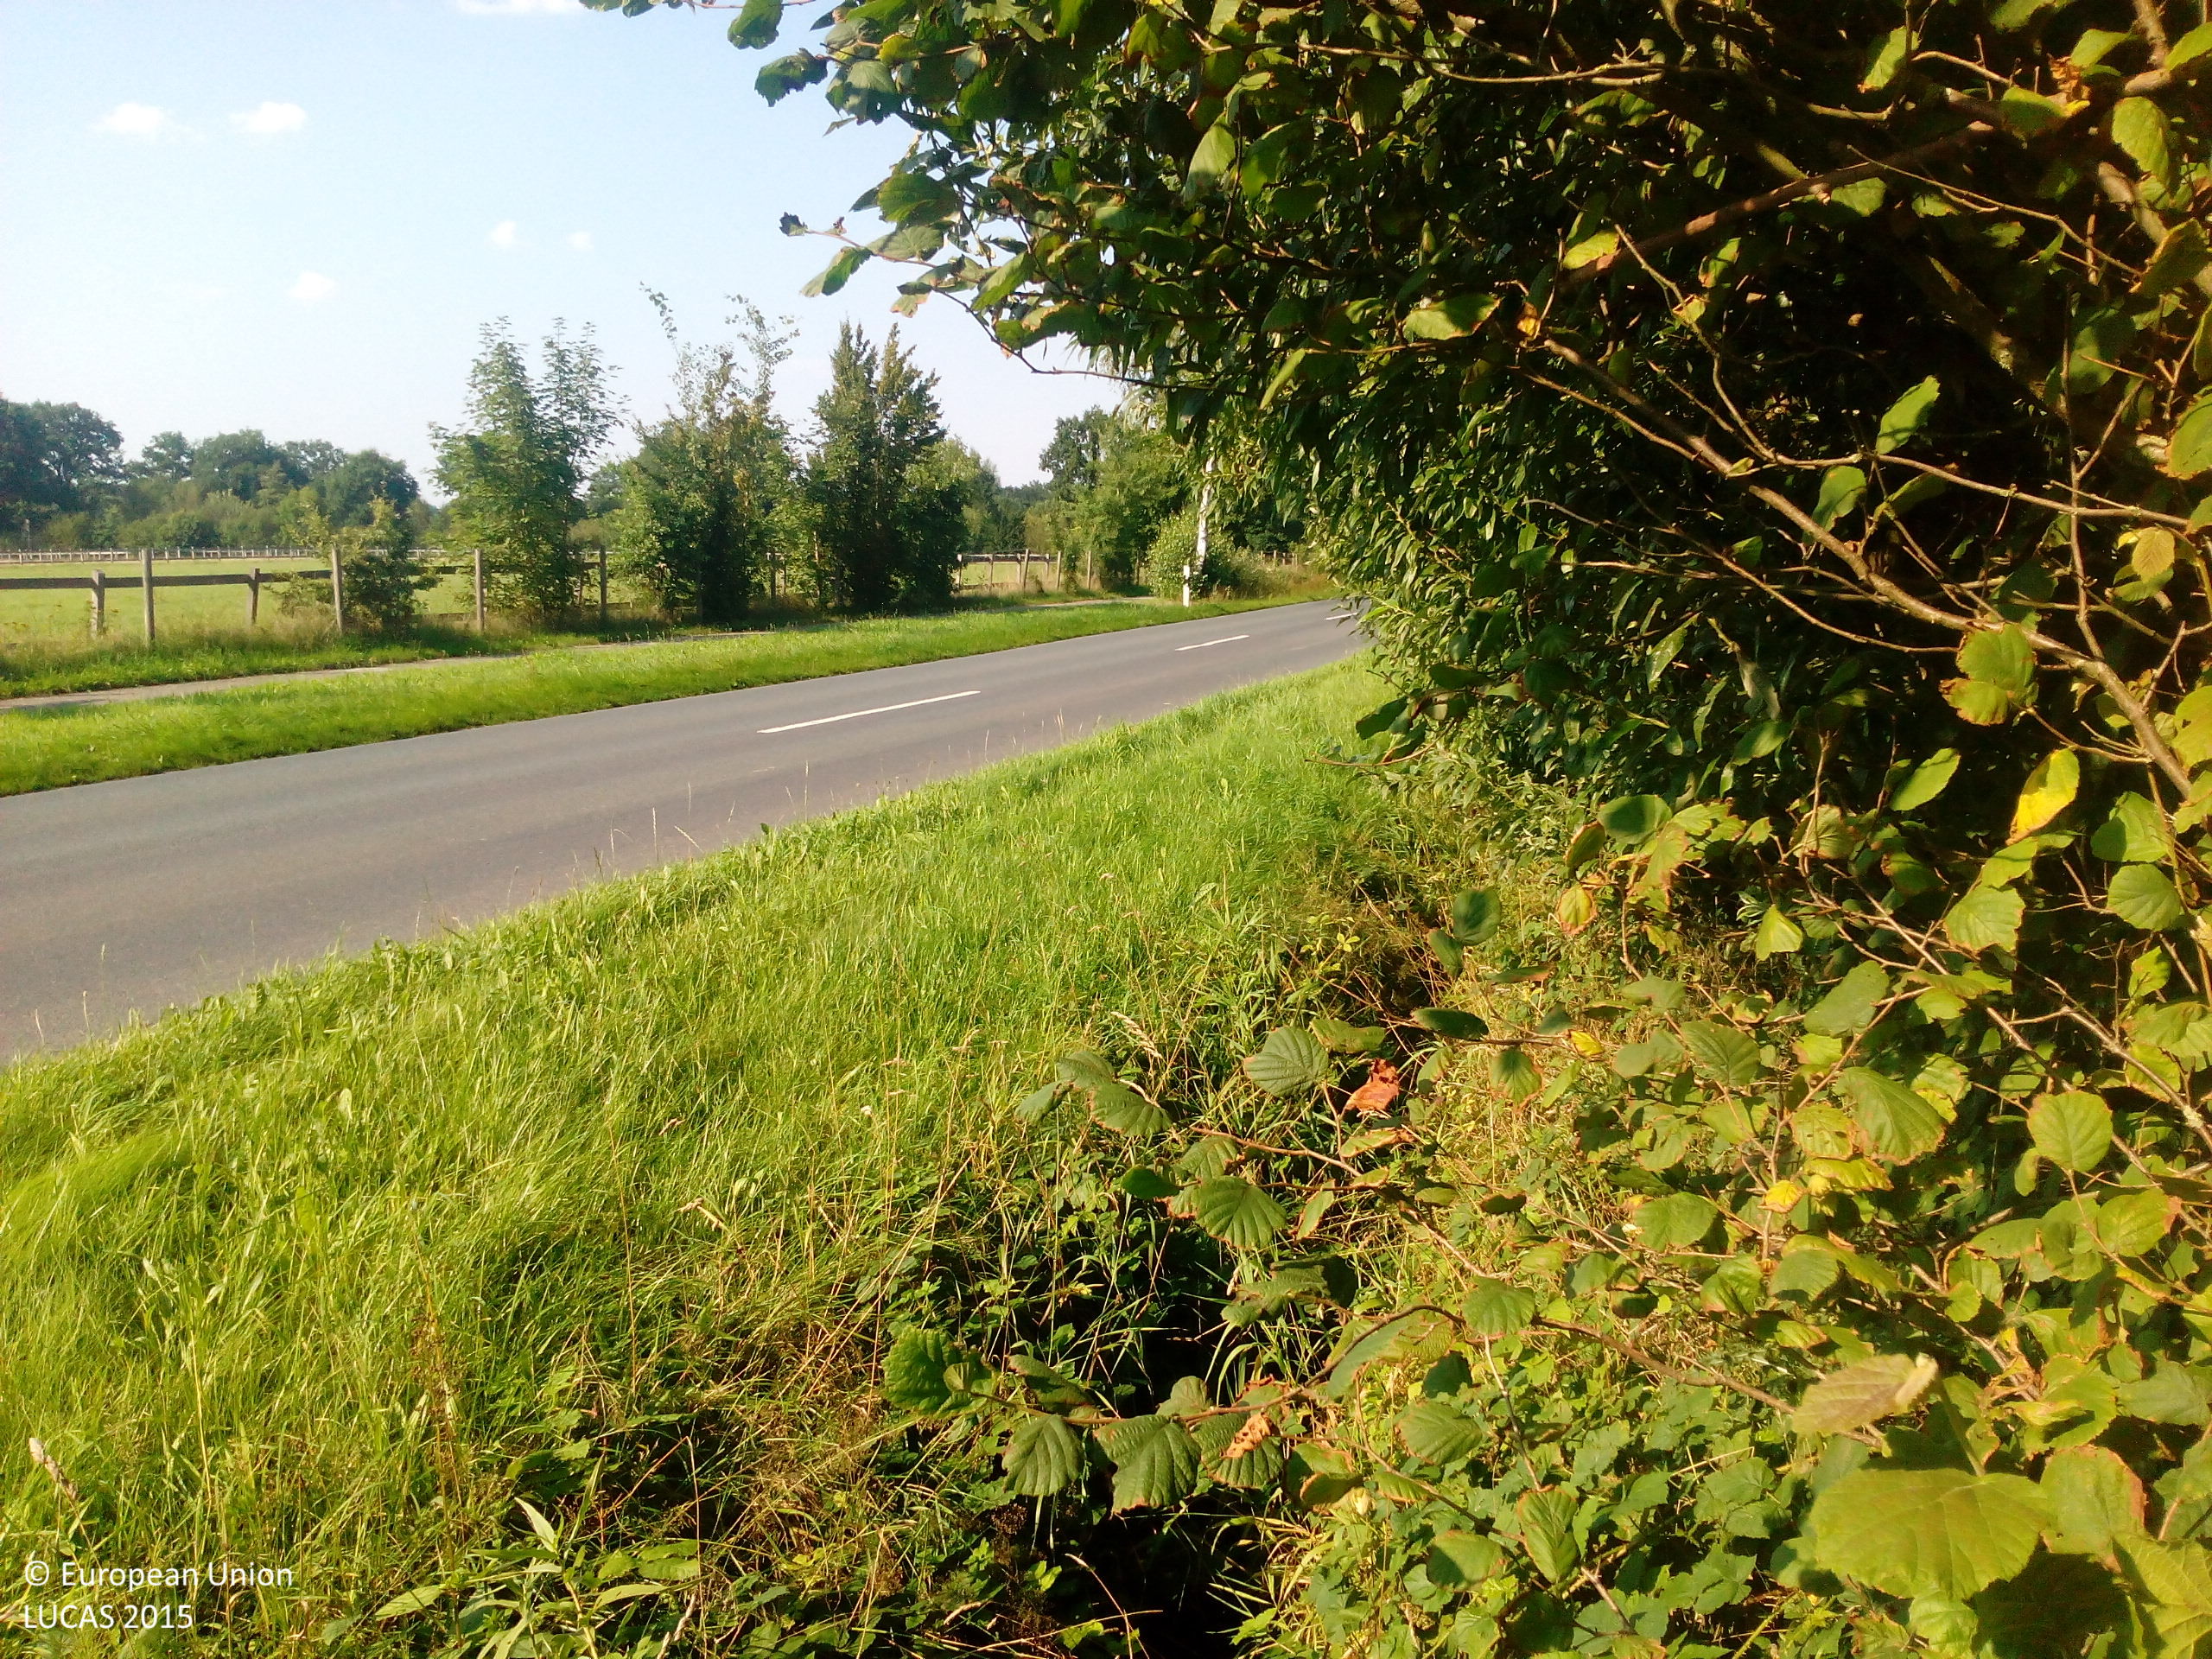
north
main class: Cropland
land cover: Maize
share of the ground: > 75 %
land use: Agriculture (excluding fallow land and kitchen gardens)
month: August
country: DE
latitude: 53.6894
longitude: 9.8638
